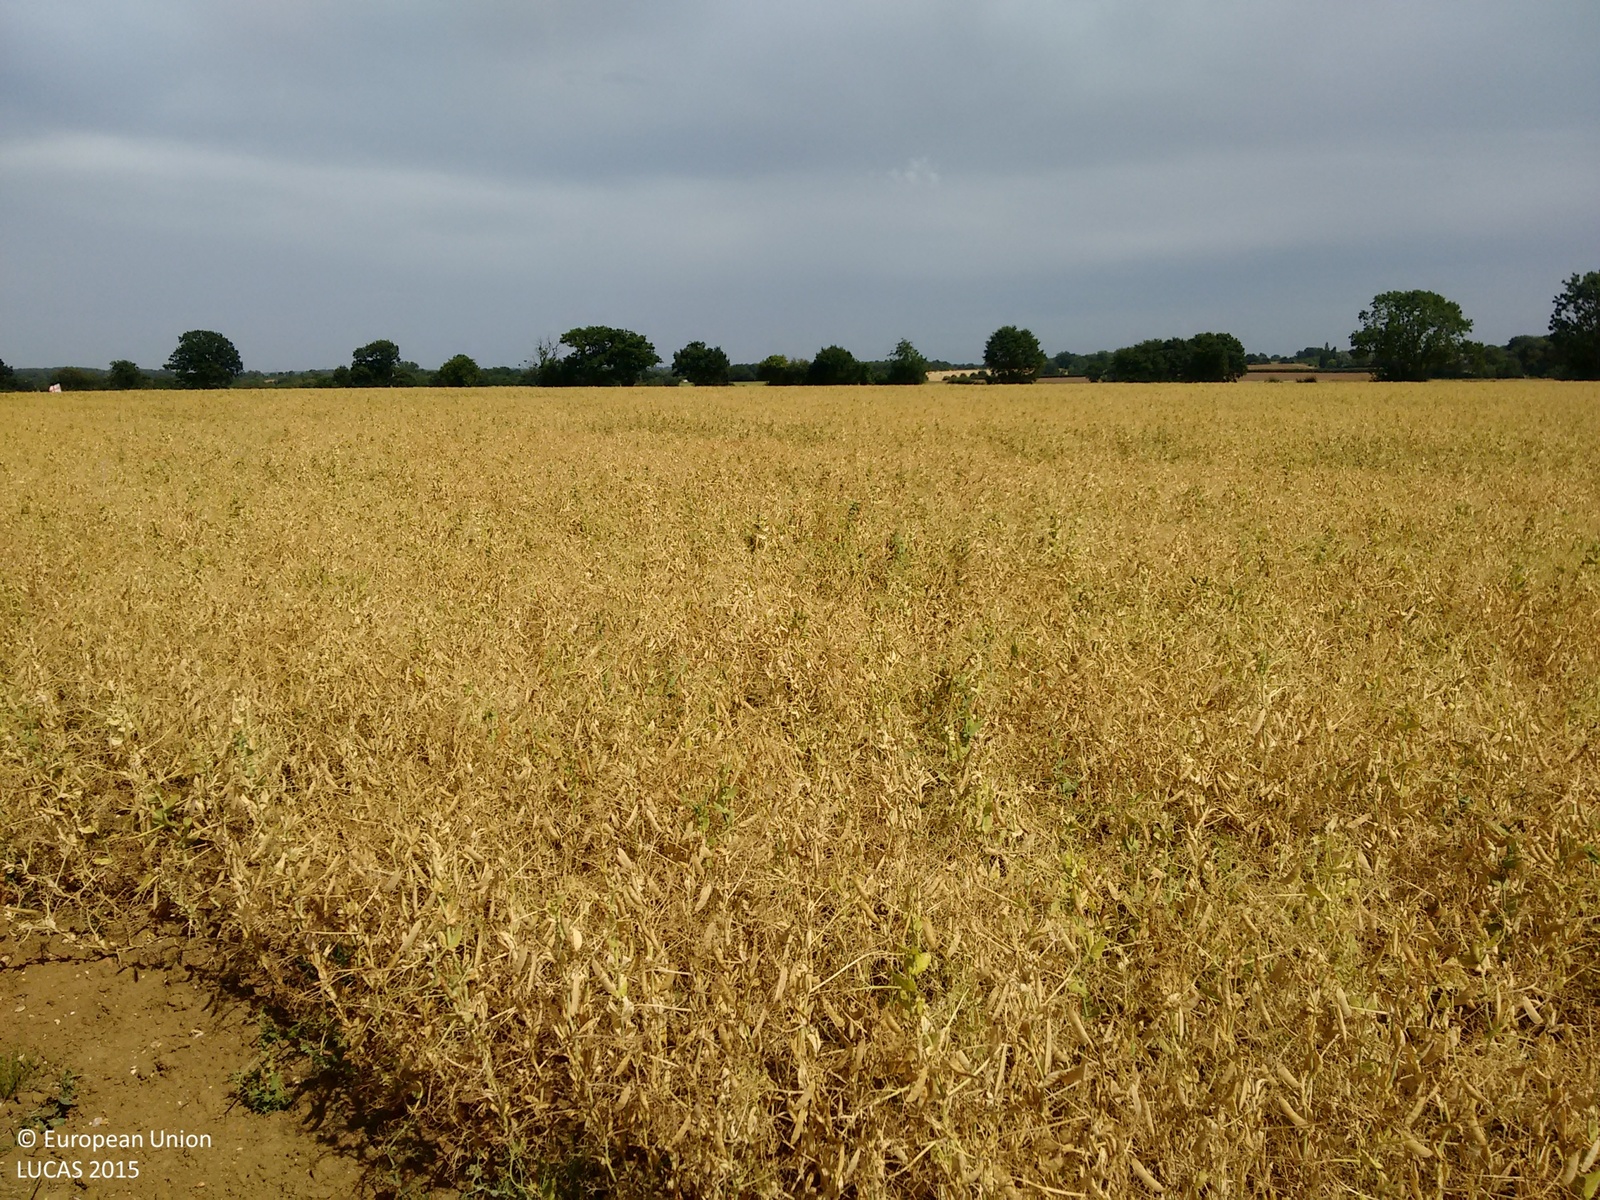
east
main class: Cropland
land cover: Dry pulses
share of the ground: > 75 %
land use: Agriculture (excluding fallow land and kitchen gardens)
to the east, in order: Dry pulses; Grassland without tree/shrub cover; Ditches and canals; Grass margins; Common wheat
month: August
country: GB
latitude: 51.9795
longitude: 0.5236
